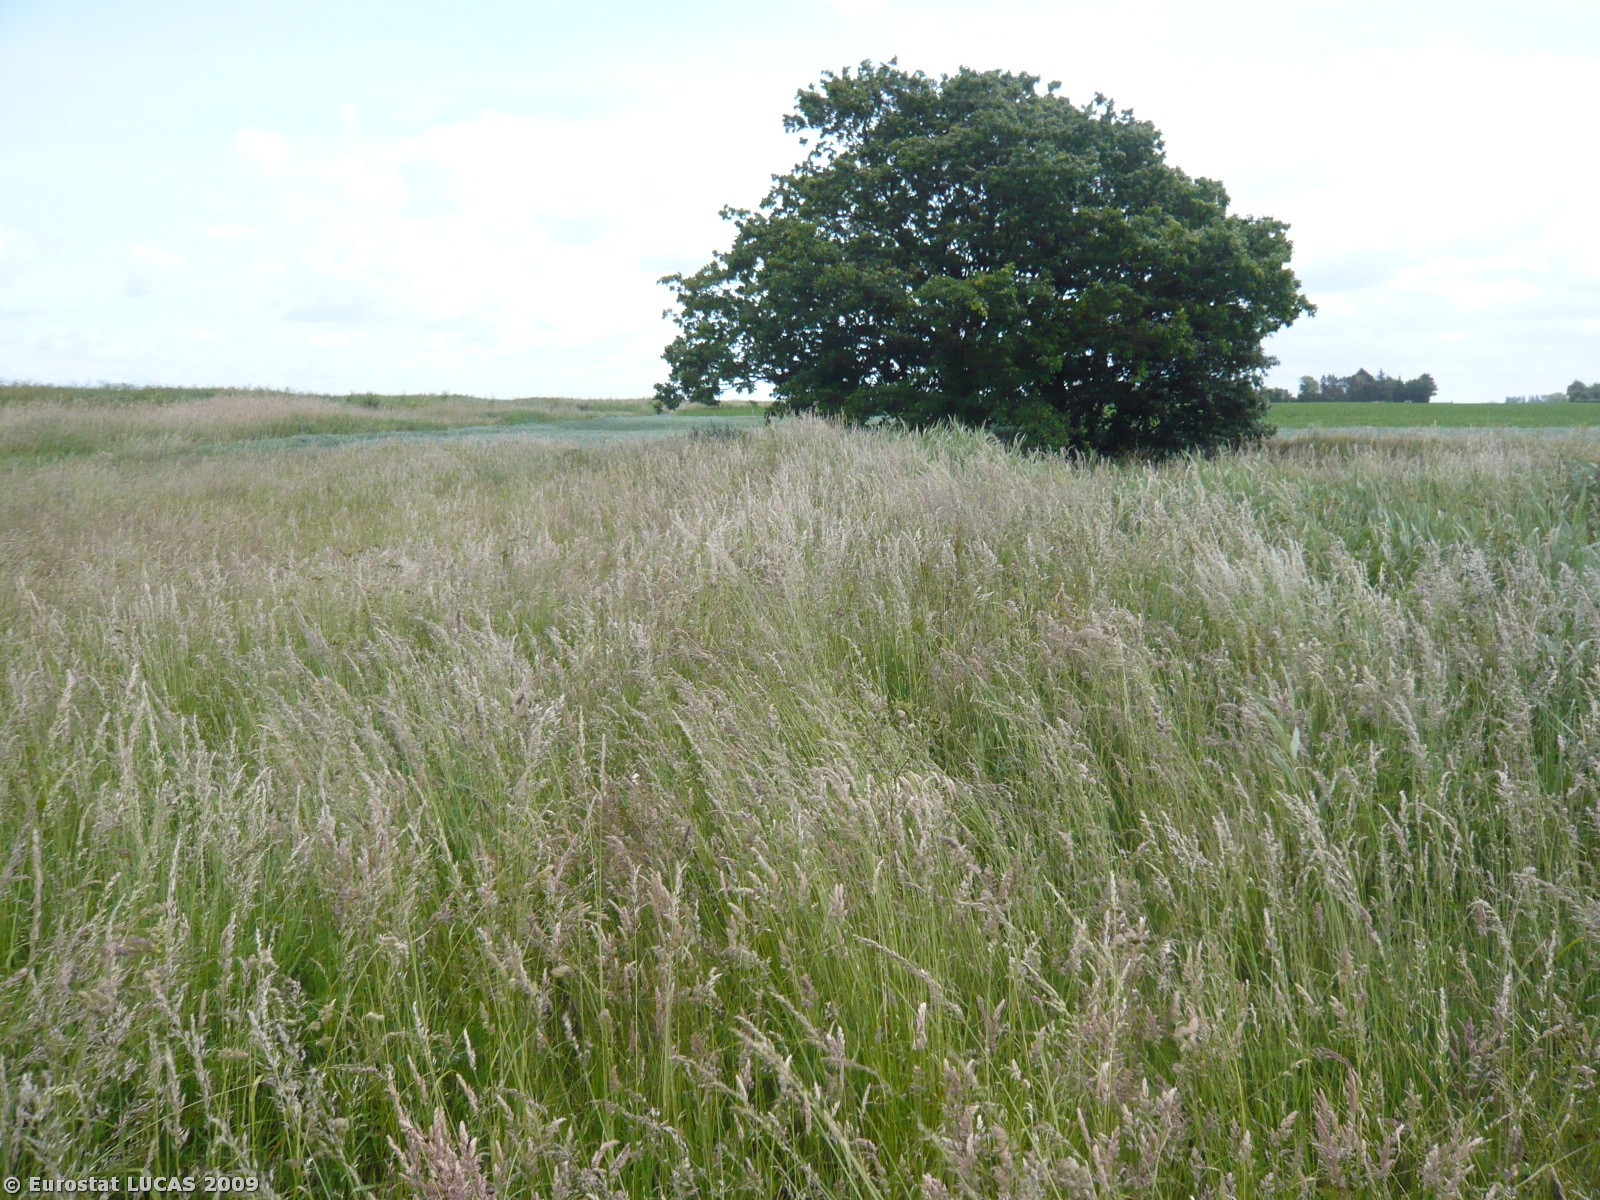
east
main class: Grassland
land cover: Grassland without tree/shrub cover
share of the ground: > 75 %
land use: Fallow land
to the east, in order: Grassland without tree/shrub cover; Shruby margins; Ditches and canals; Shruby margins; Ditches and canals; Single bushes/trees; Grass margins; Oats; Sugar beet; Oats; Sugar beet
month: June
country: DK
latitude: 54.9597
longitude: 11.2016
